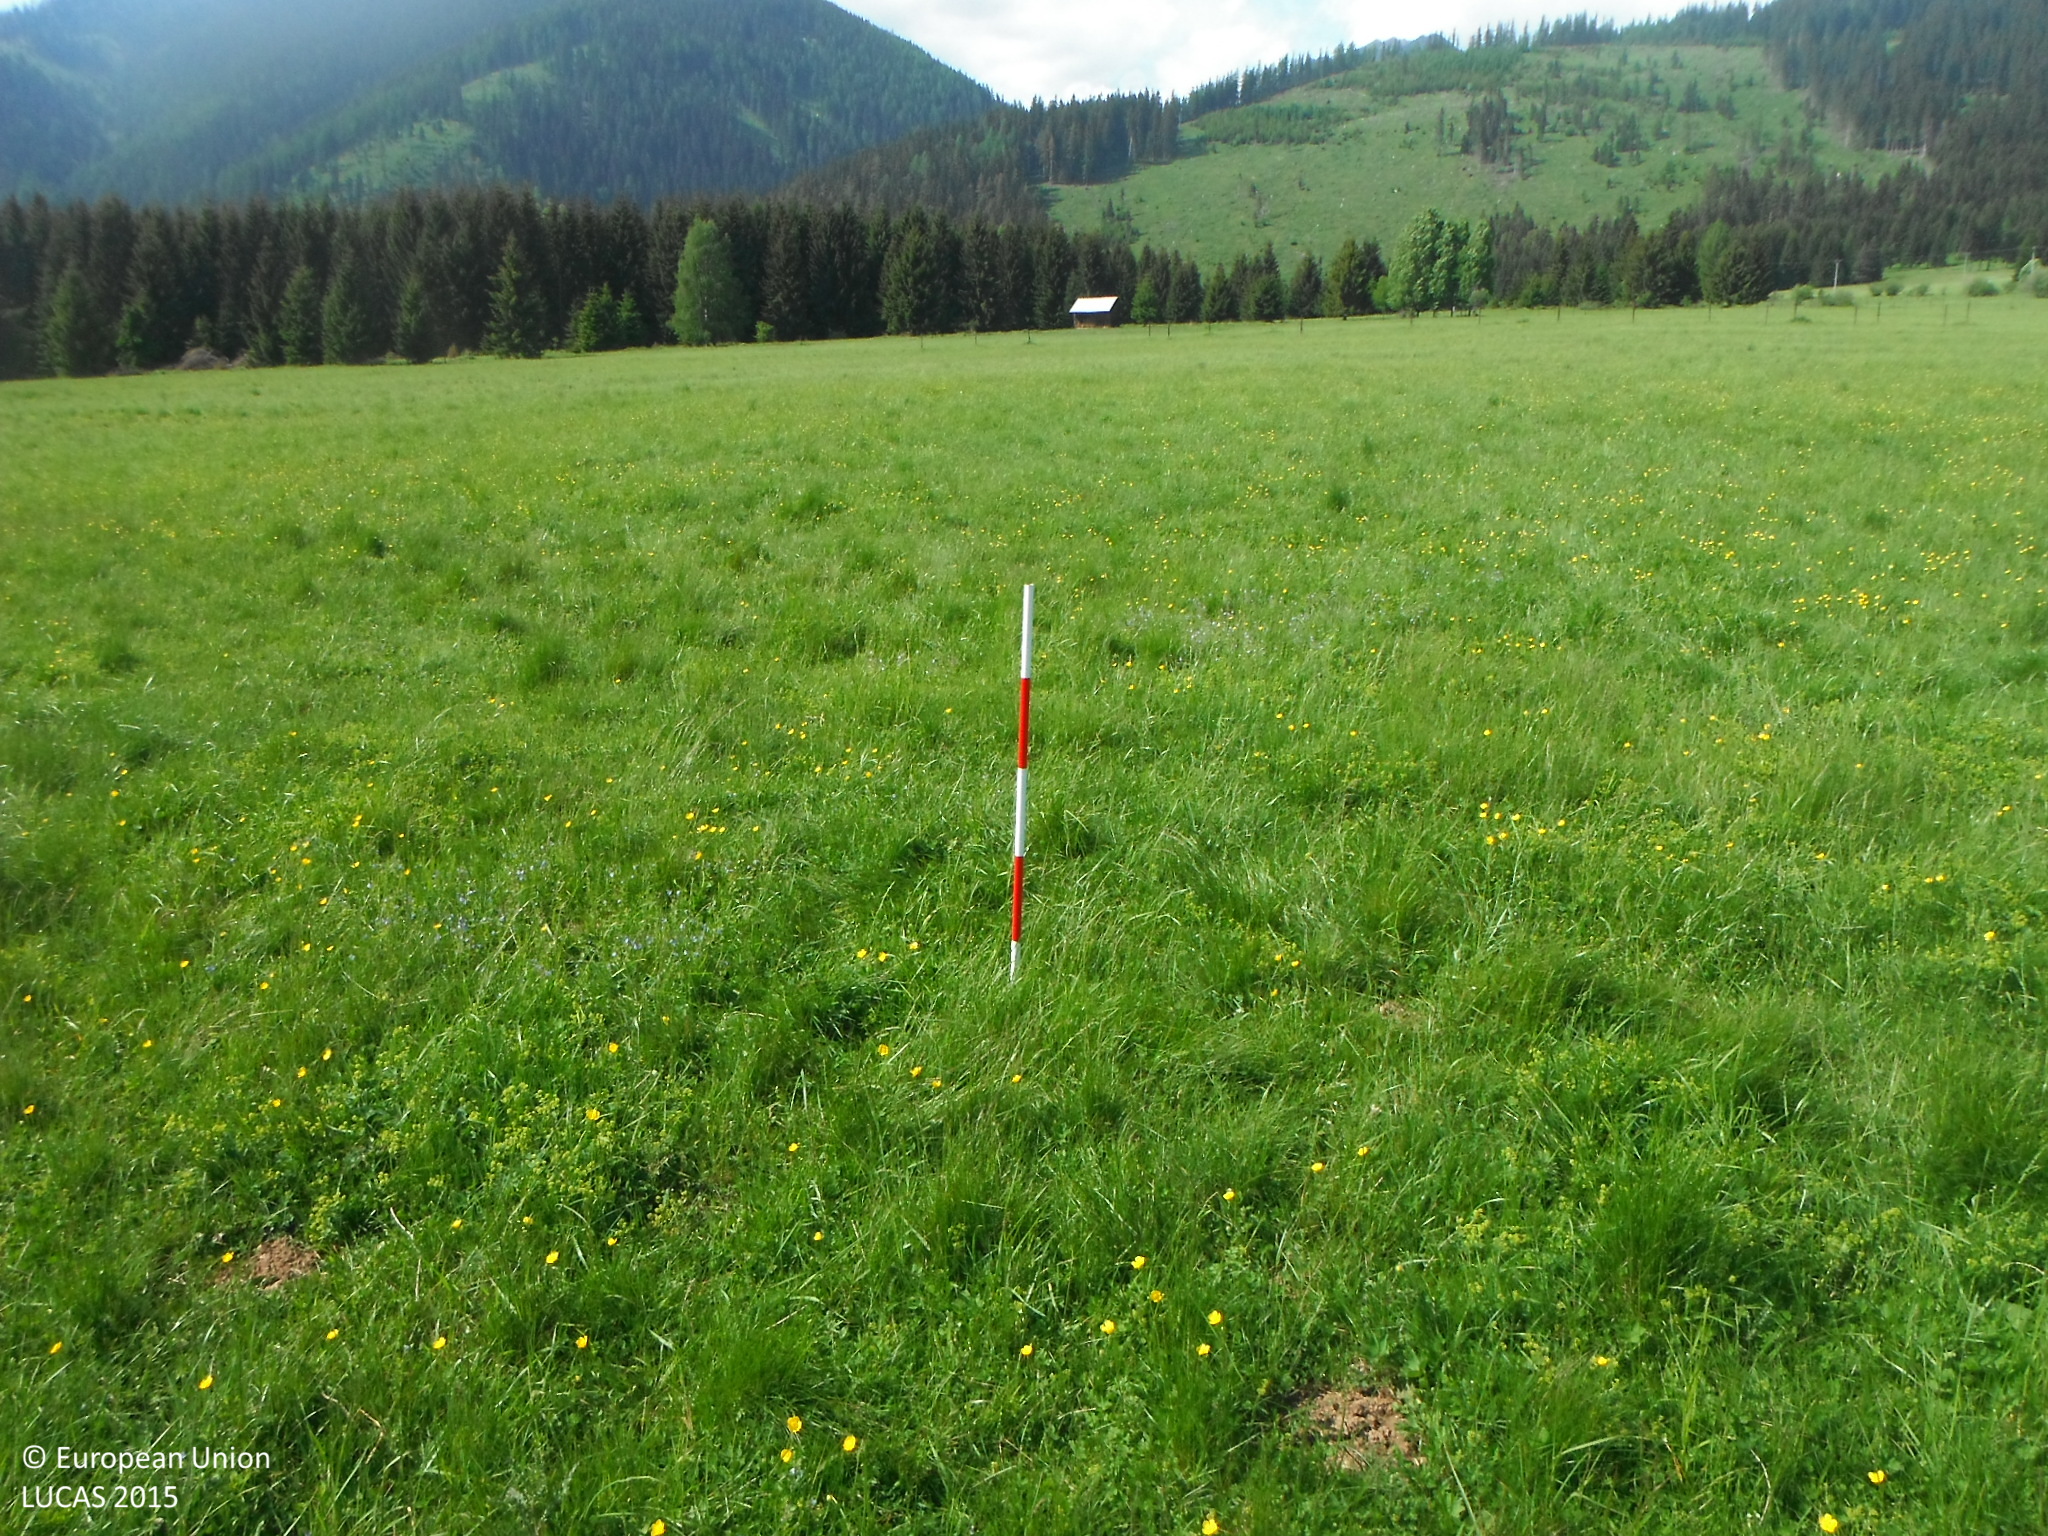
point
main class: Grassland
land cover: Grassland without tree/shrub cover
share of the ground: > 75 %
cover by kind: herbaceous plants 100 %
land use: Agriculture (excluding fallow land and kitchen gardens)
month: June
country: SK
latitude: 49.1270
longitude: 19.7998
